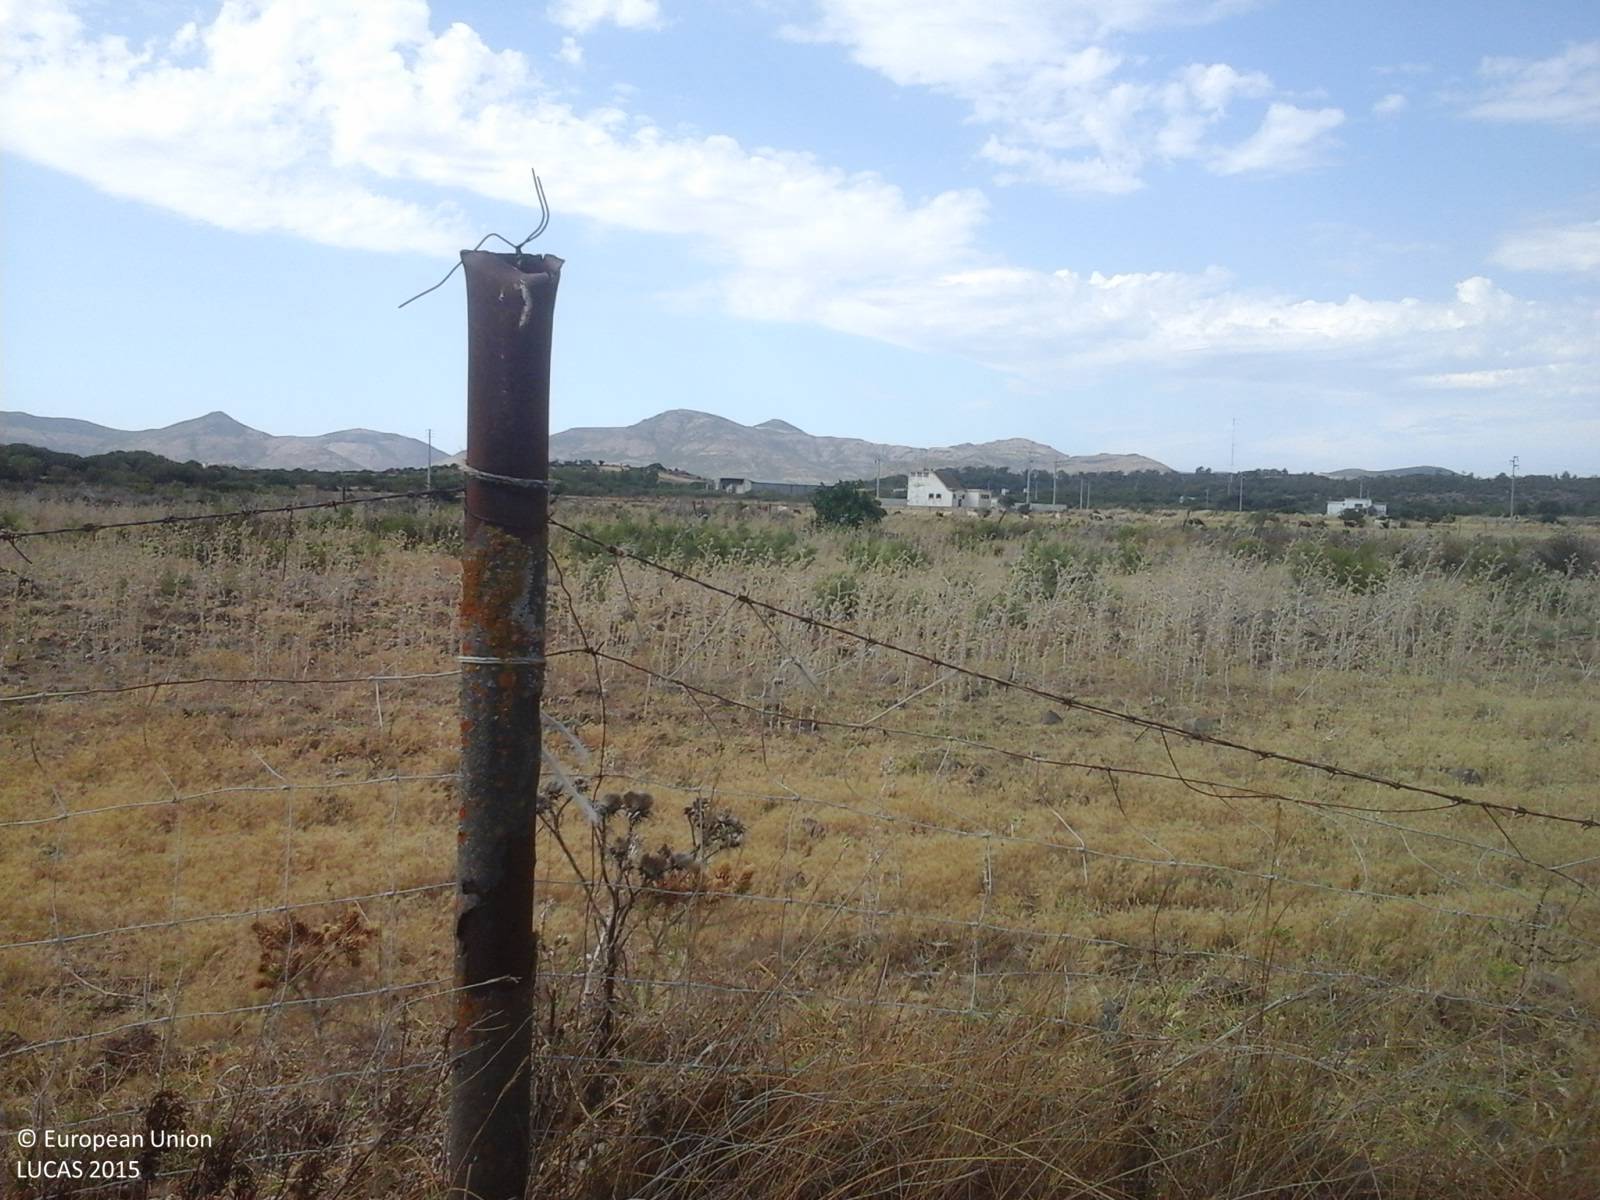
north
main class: Grassland
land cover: Grassland without tree/shrub cover
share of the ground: > 75 %
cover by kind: herbaceous plants 85 %, unconsolidated bare surface 15 %
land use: Agriculture (excluding fallow land and kitchen gardens)
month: July
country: IT
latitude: 39.0796
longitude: 8.5871
